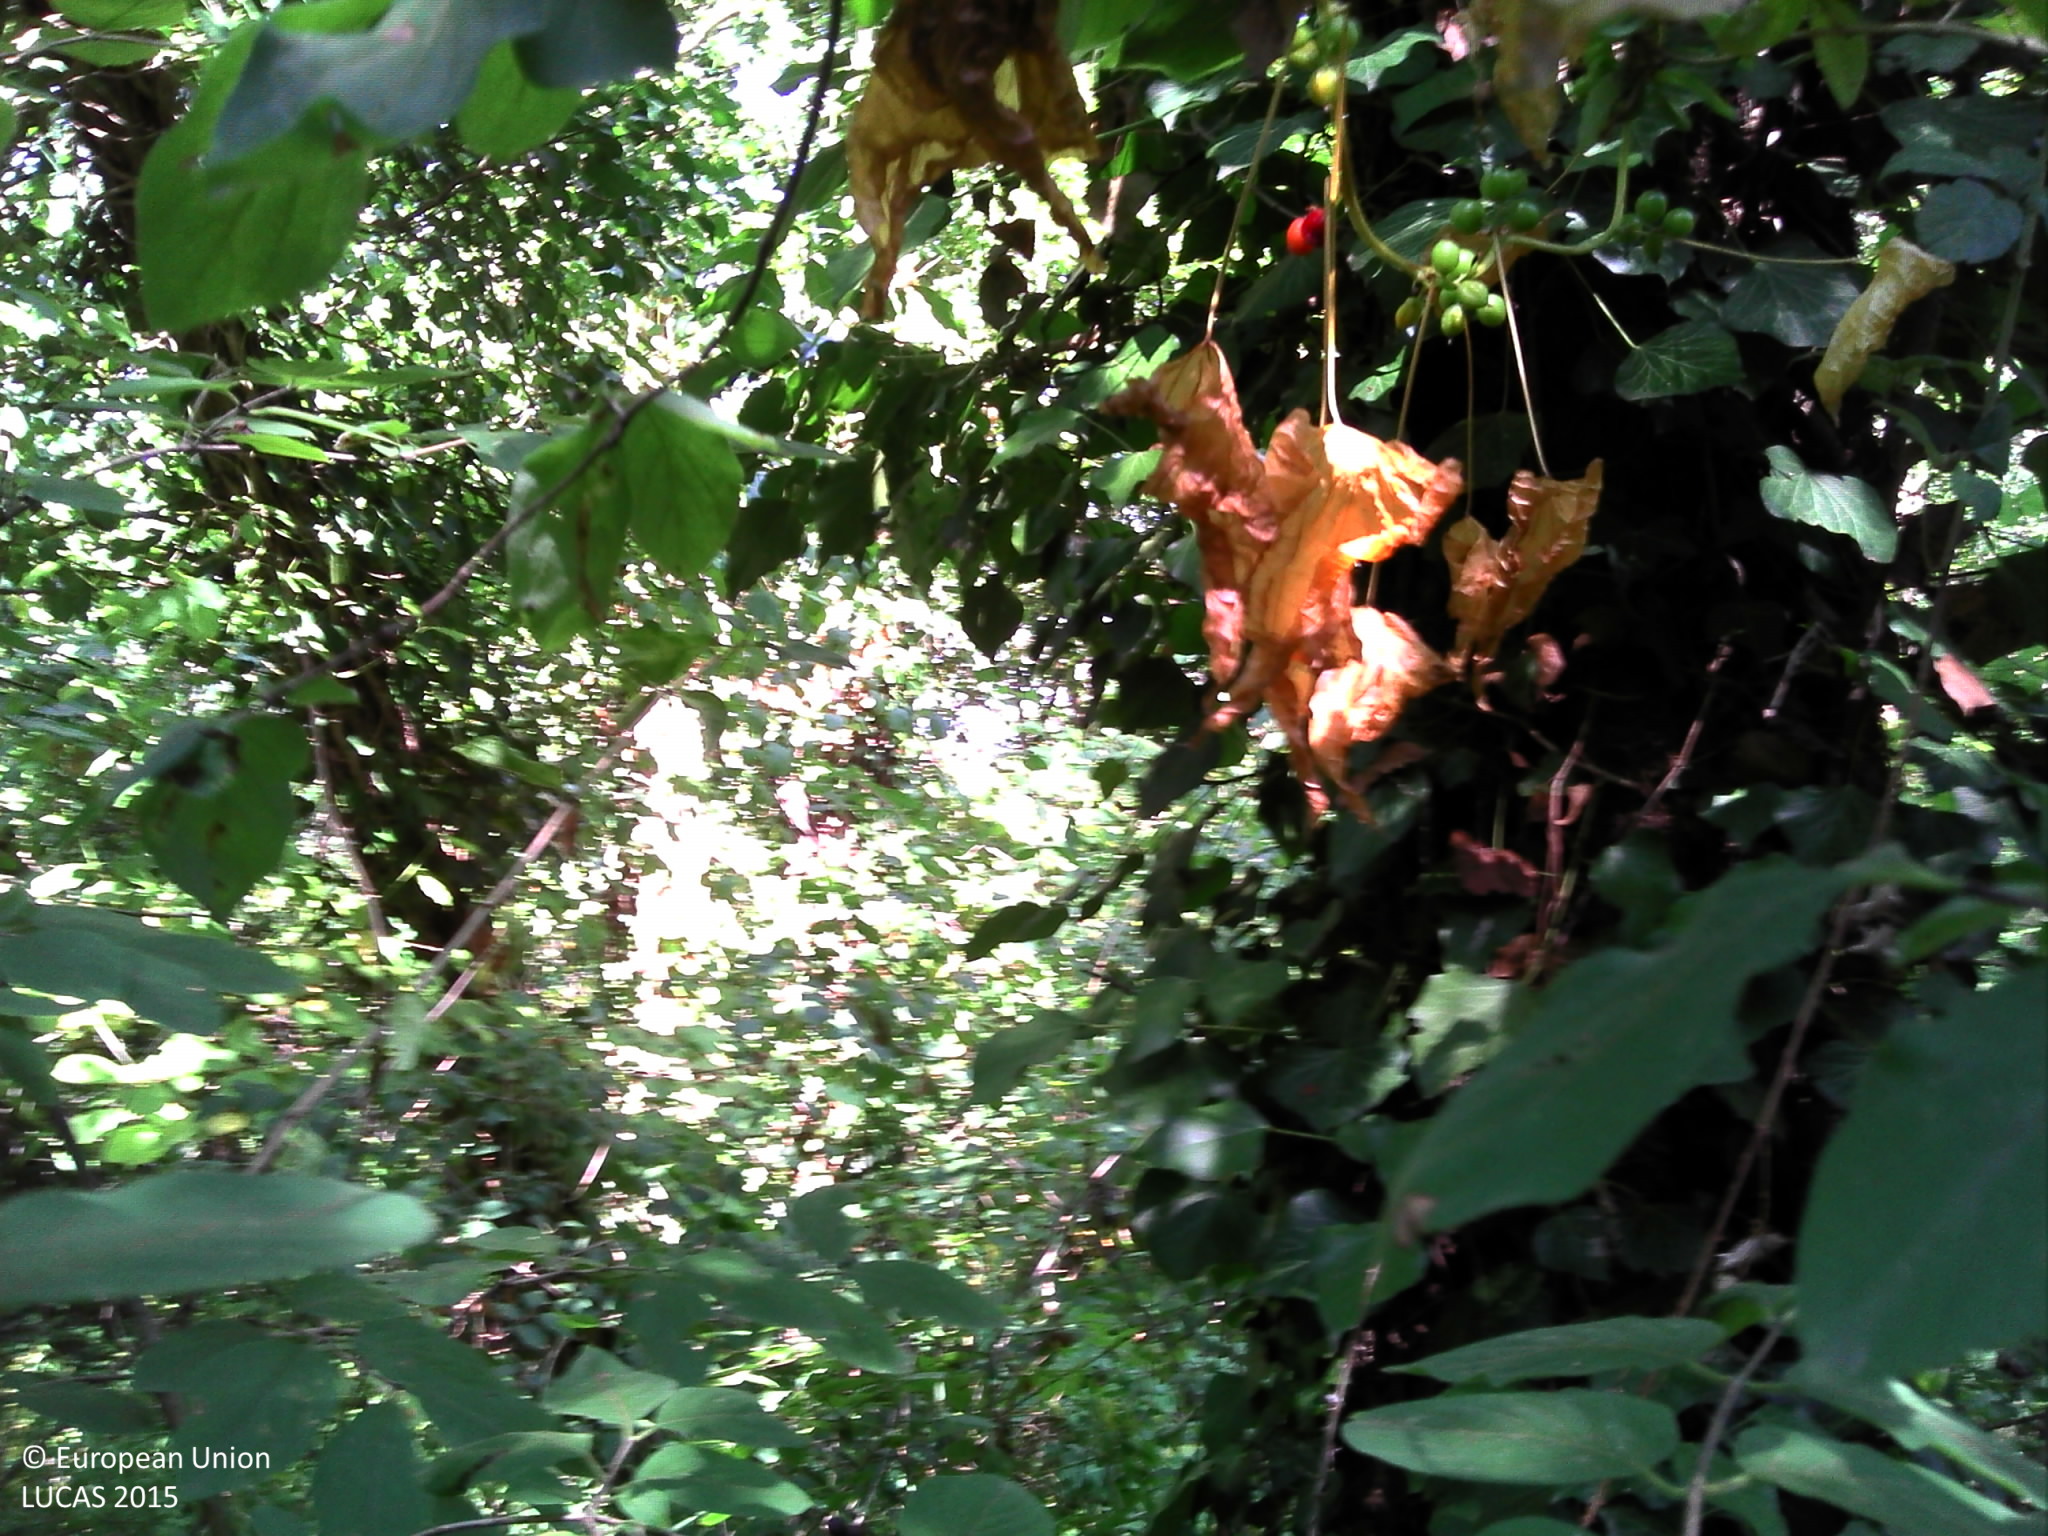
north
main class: Woodland
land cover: Pine dominated mixed woodland
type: hemiboreal forest and nemoral coniferous forest and mixed broadleaved-coniferous forest
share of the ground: > 75 %
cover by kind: coniferous forest trees 60 %, broadleaved forest trees 30 %, herbaceous plants 5 %, lichens and mosses 5 %
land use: Forestry
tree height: > 5 m
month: August
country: FR
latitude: 47.8667
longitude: 3.4580
